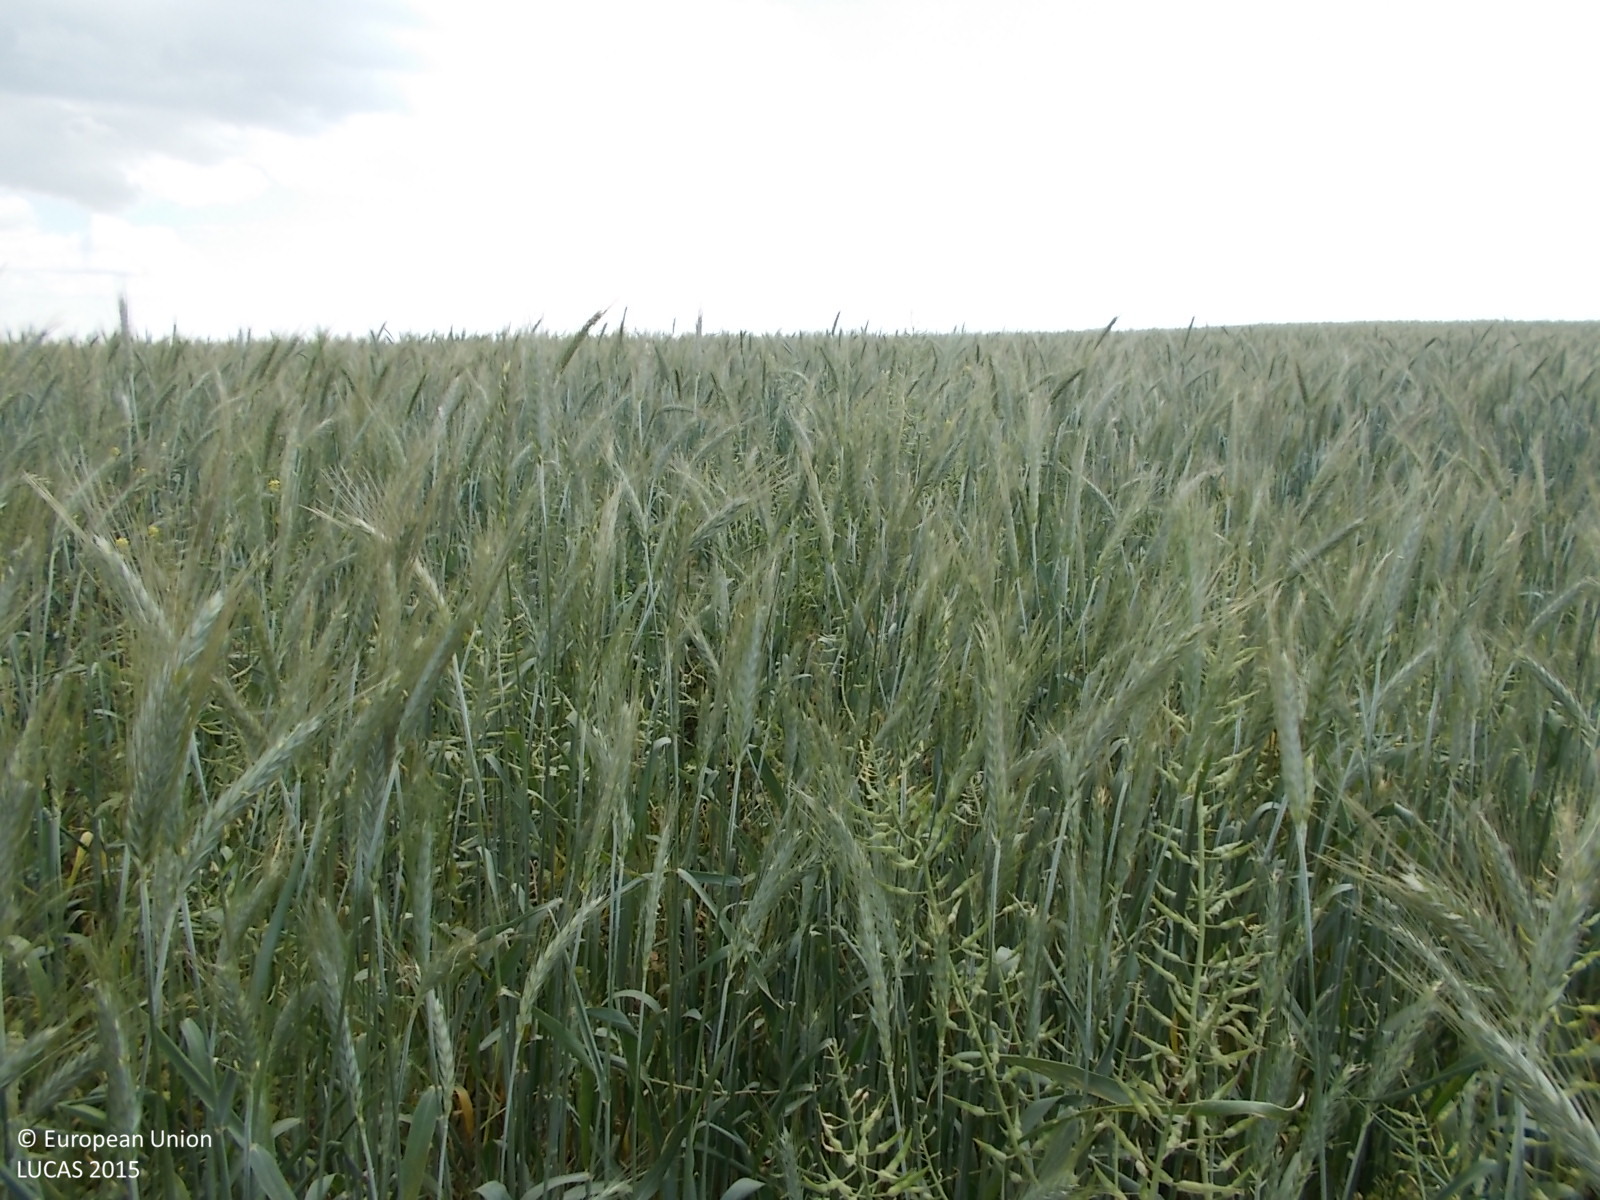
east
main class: Cropland
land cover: Mixed cereals for fodder
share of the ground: > 75 %
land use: Agriculture (excluding fallow land and kitchen gardens)
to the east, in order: Mixed cereals for fodder; Spontaneously vegetated surfaces; Shrubland without tree cover; Spontaneously vegetated surfaces; Common wheat
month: April
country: CY
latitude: 35.0427
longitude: 33.4902
